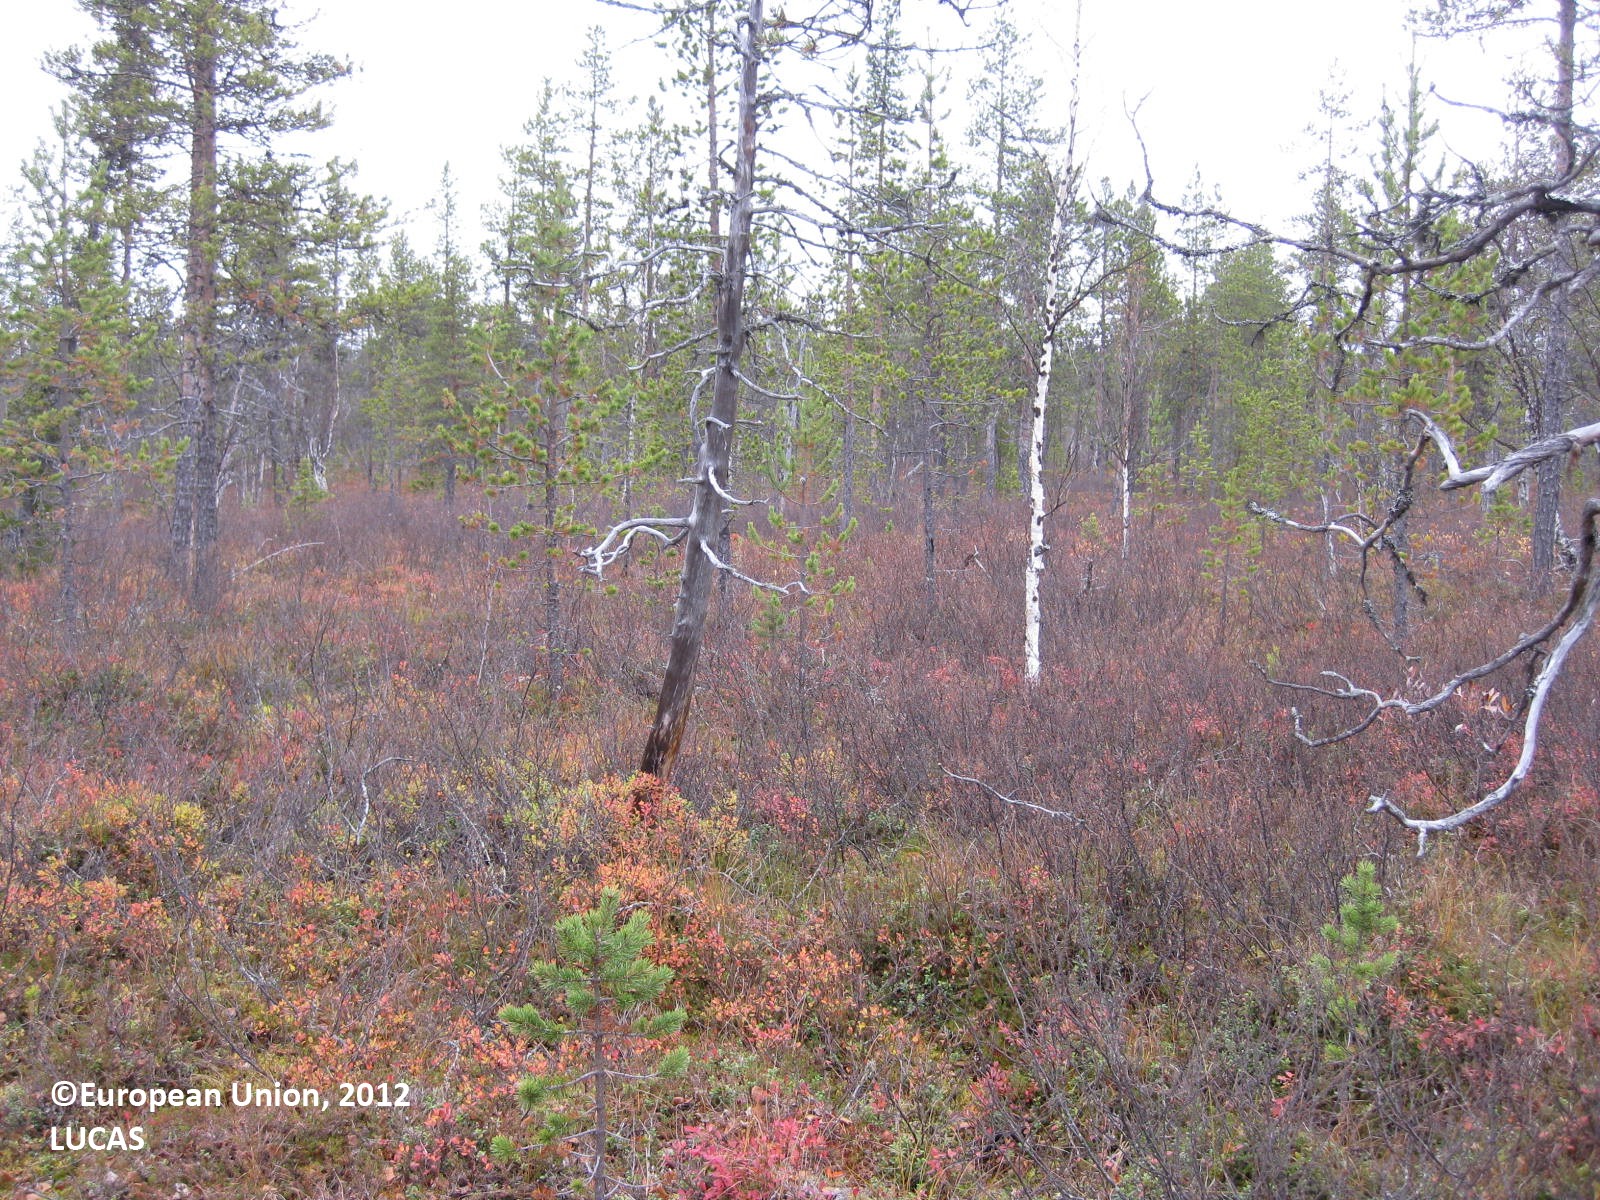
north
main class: Woodland
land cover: Other mixed woodland
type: boreal forest
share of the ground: > 75 %
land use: Forestry
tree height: > 5 m
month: September
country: FI
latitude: 68.0828
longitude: 23.6212
